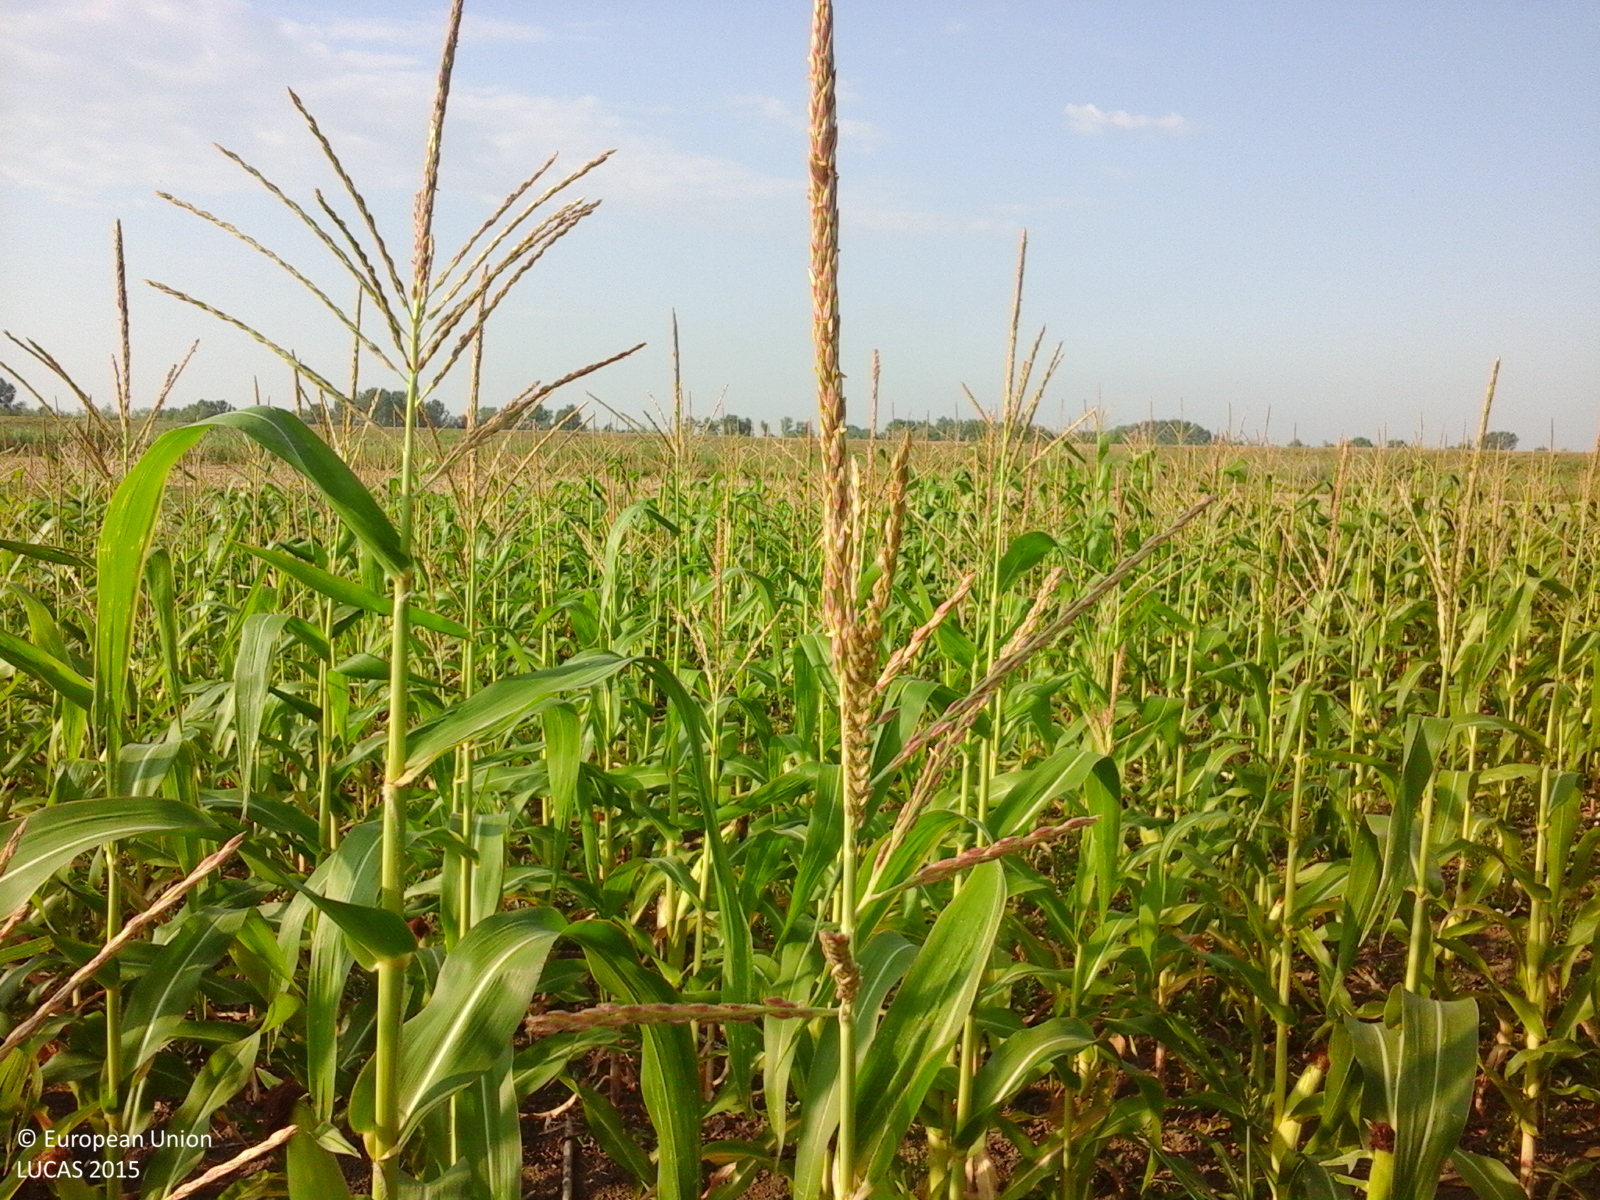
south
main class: Cropland
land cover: Maize
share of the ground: > 75 %
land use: Agriculture (excluding fallow land and kitchen gardens)
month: July
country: RO
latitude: 46.2921
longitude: 28.1604
